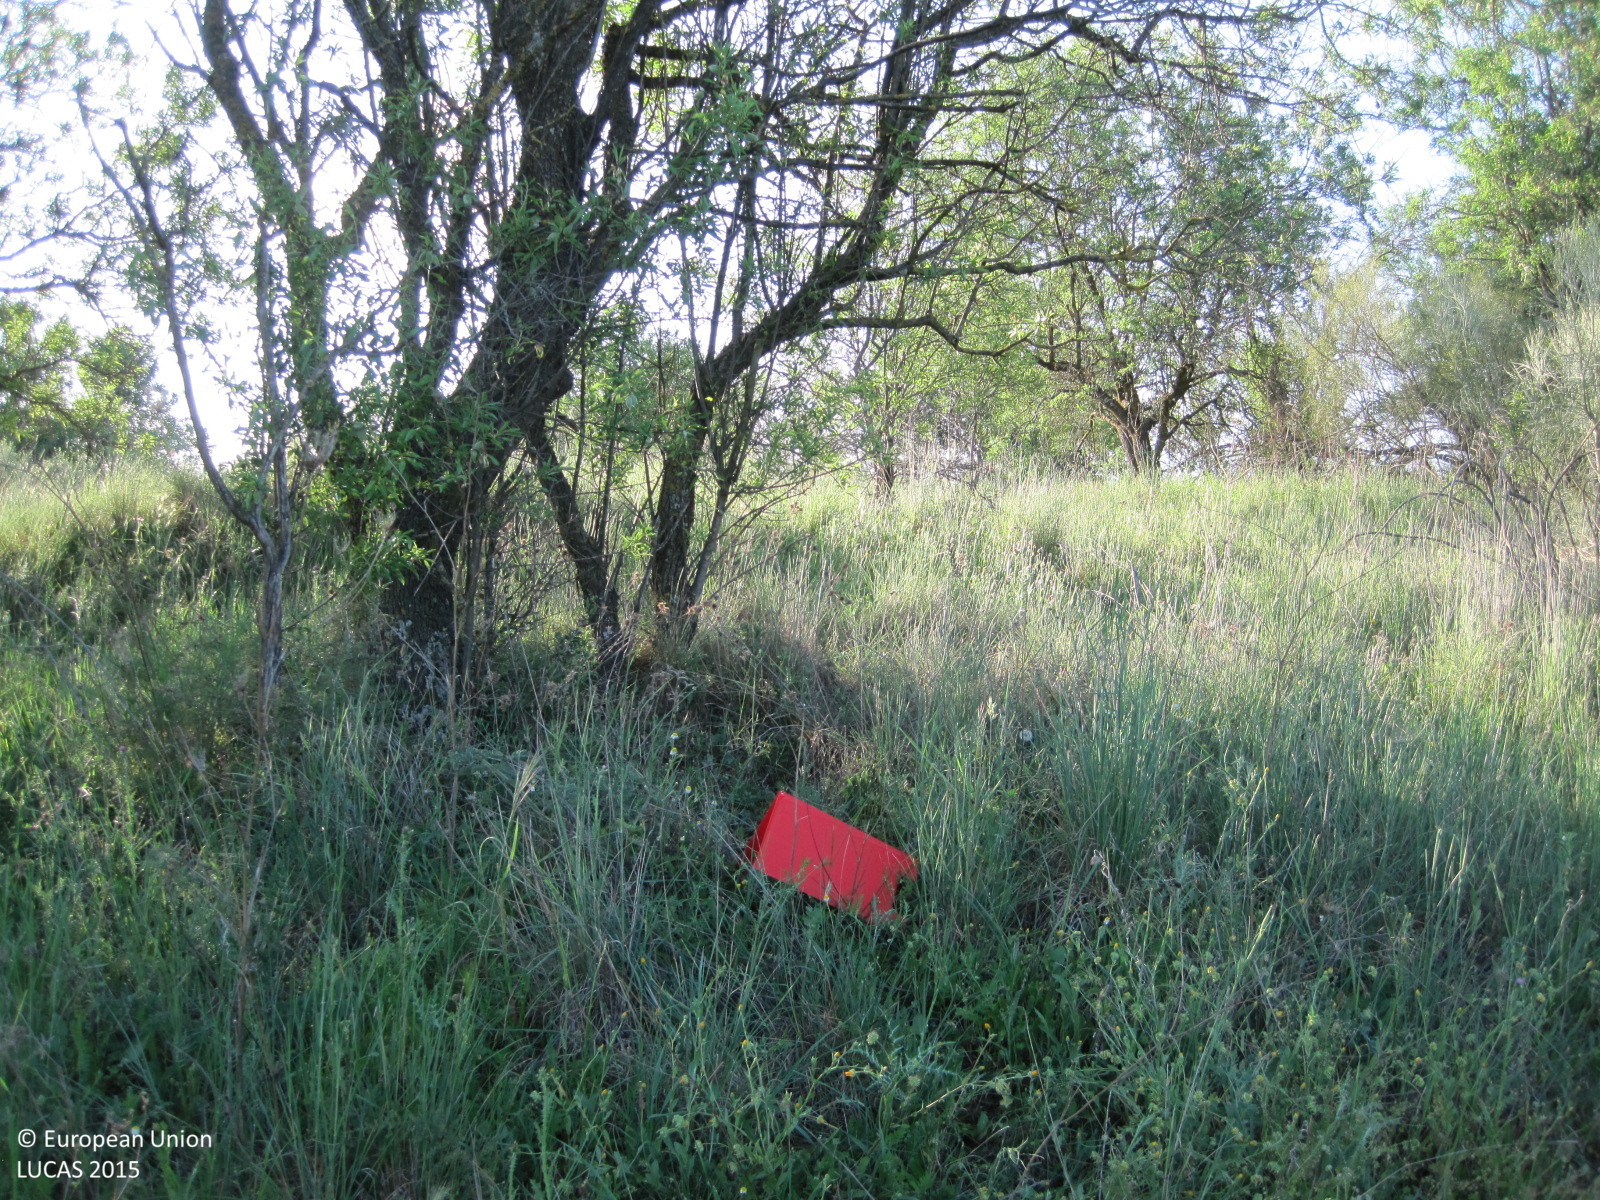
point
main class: Woodland
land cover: Broadleaved woodland
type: thermophilous deciduous forest
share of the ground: 10 - 25 %
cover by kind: herbaceous plants 50 %, shrubs 35 %, broadleaved forest trees 15 %
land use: Agriculture (excluding fallow land and kitchen gardens)
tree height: < 5 m
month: April
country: ES
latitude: 39.8563
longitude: -4.9039
